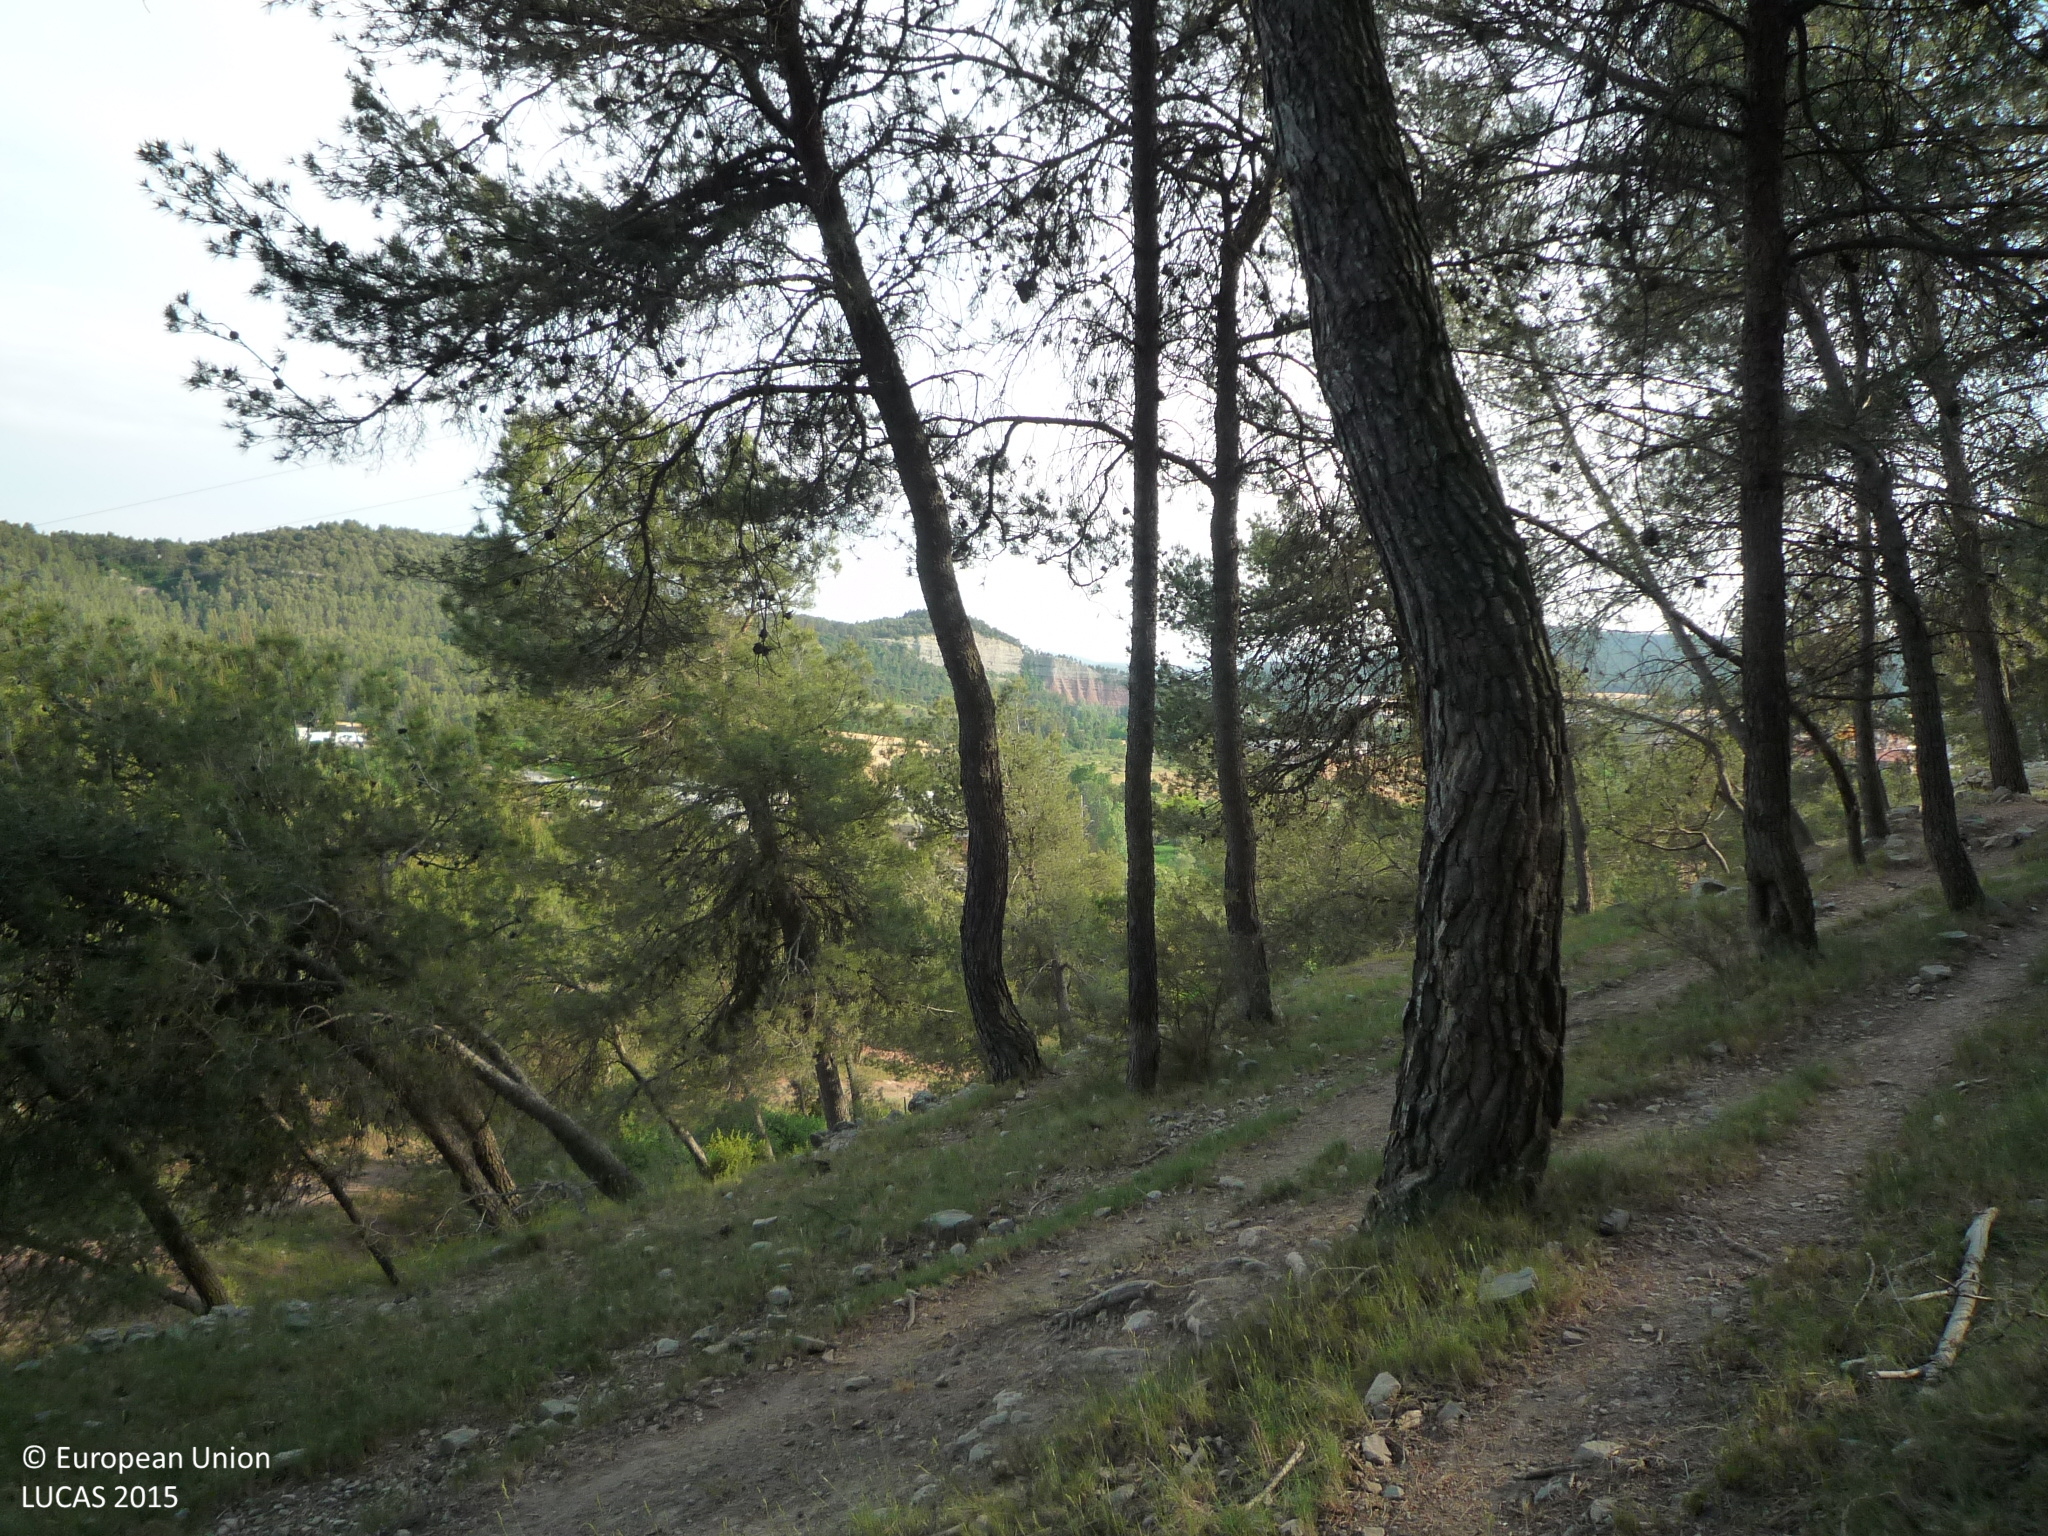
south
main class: Woodland
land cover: Pine dominated coniferous woodland
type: coniferous forest of the mediterranean region
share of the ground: > 75 %
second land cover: Grassland without tree/shrub cover
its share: 10 - 25 %
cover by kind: coniferous forest trees 75 %, herbaceous plants 25 %
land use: Forestry
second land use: Agriculture (excluding fallow land and kitchen gardens)
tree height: > 5 m
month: May
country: ES
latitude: 41.8638
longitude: 1.9793
